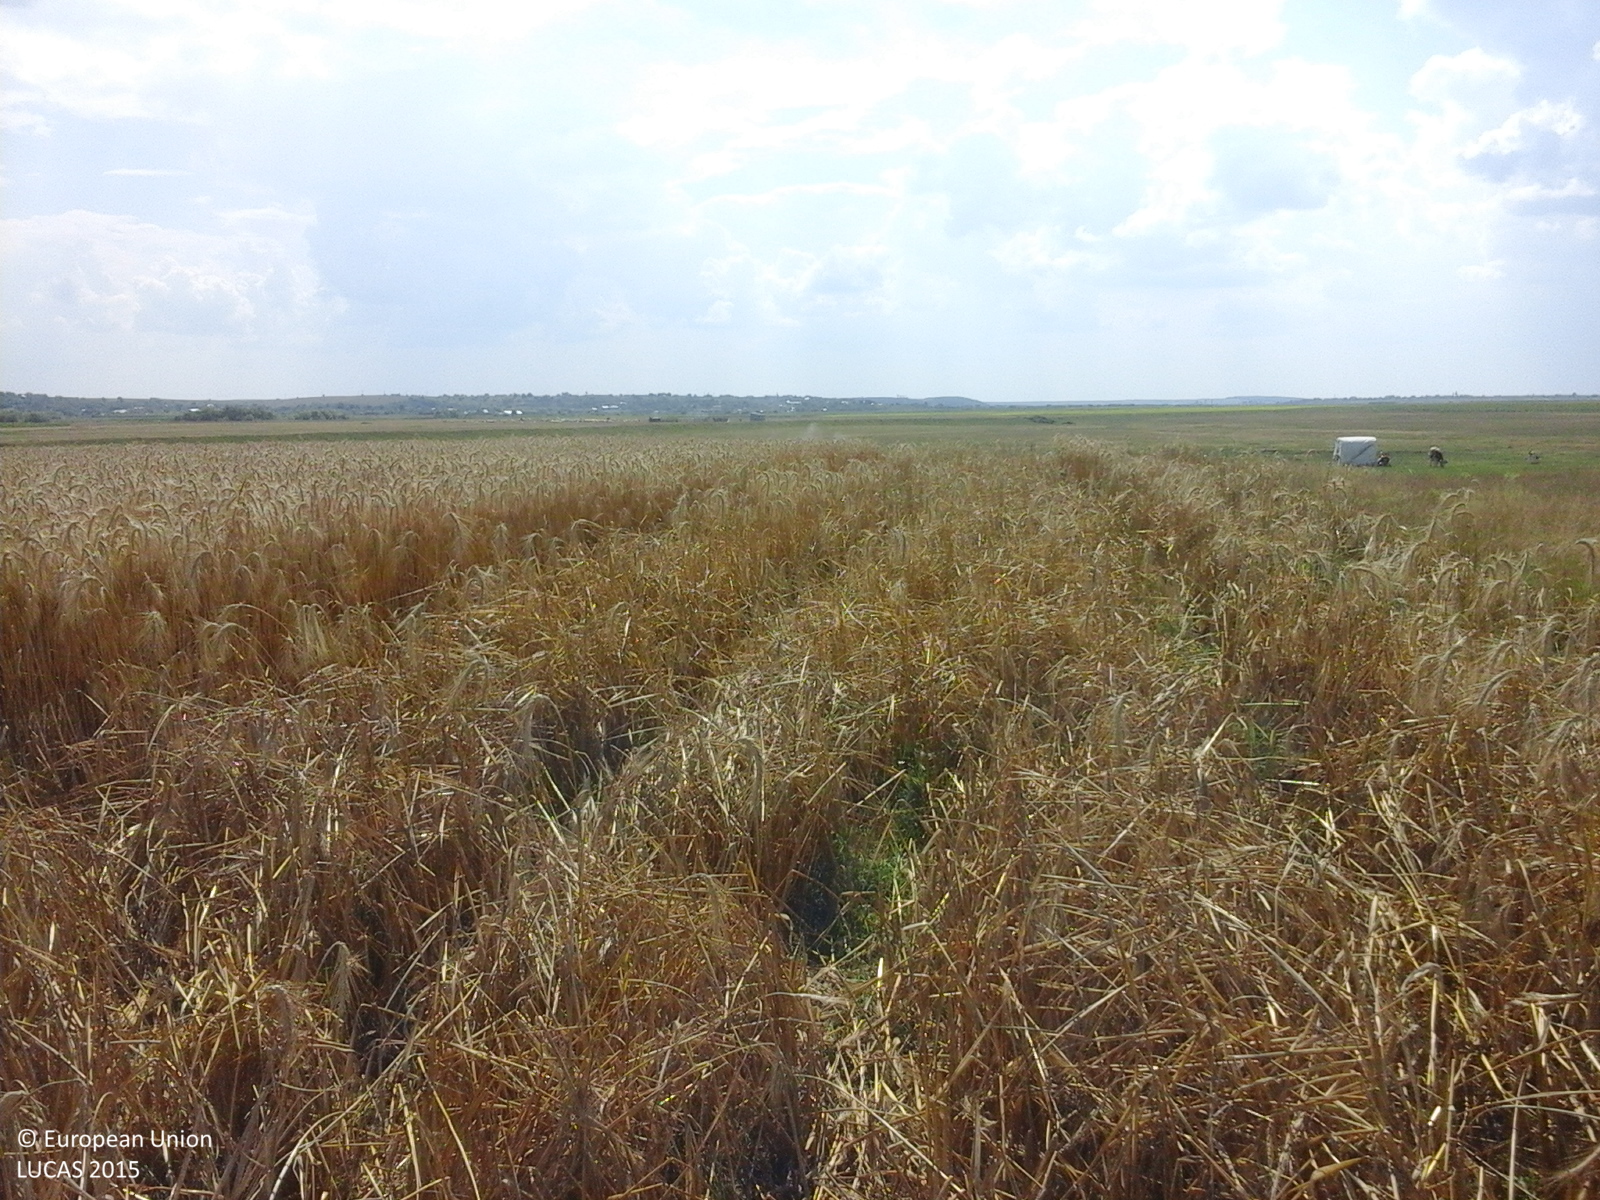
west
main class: Cropland
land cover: Barley
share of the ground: > 75 %
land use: Agriculture (excluding fallow land and kitchen gardens)
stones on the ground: < 10 %
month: July
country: RO
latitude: 44.1589
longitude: 25.9158
